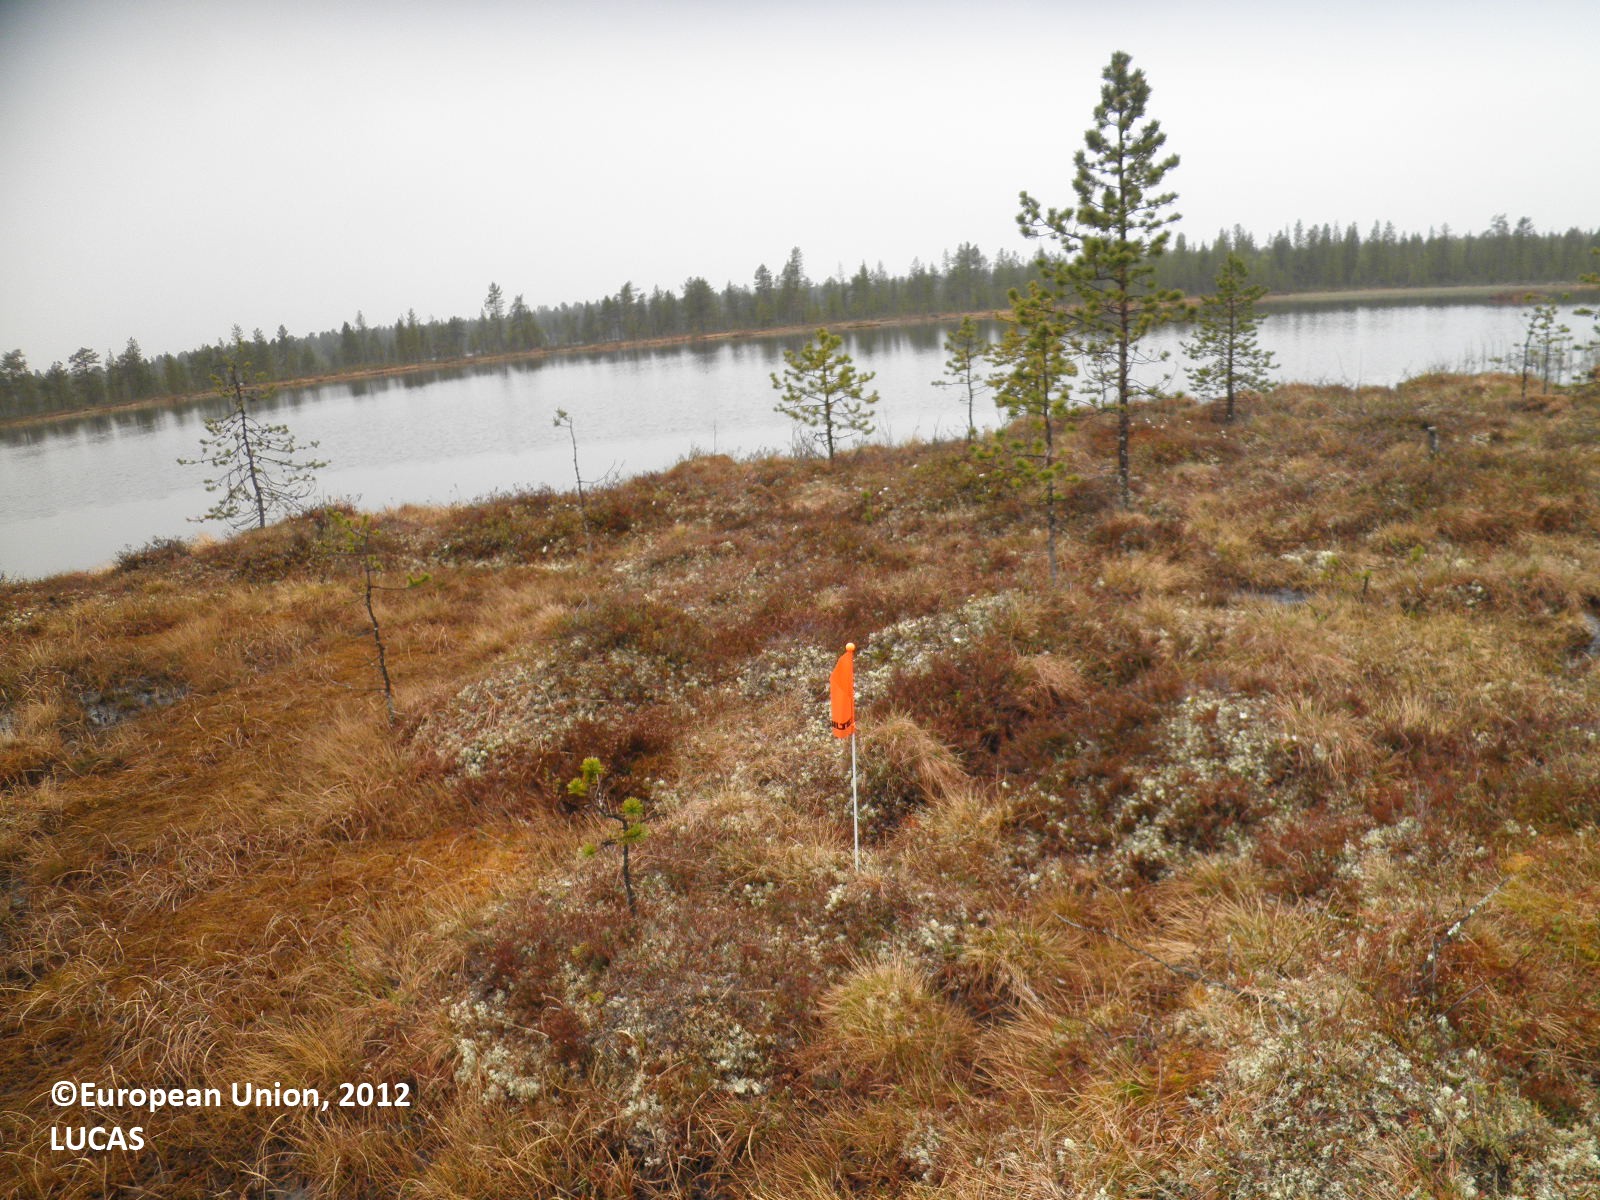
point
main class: Woodland
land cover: Pine dominated coniferous woodland
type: boreal forest
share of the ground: 10 - 25 %
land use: Forestry
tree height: > 5 m
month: June
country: FI
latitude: 69.1158
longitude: 27.2292
